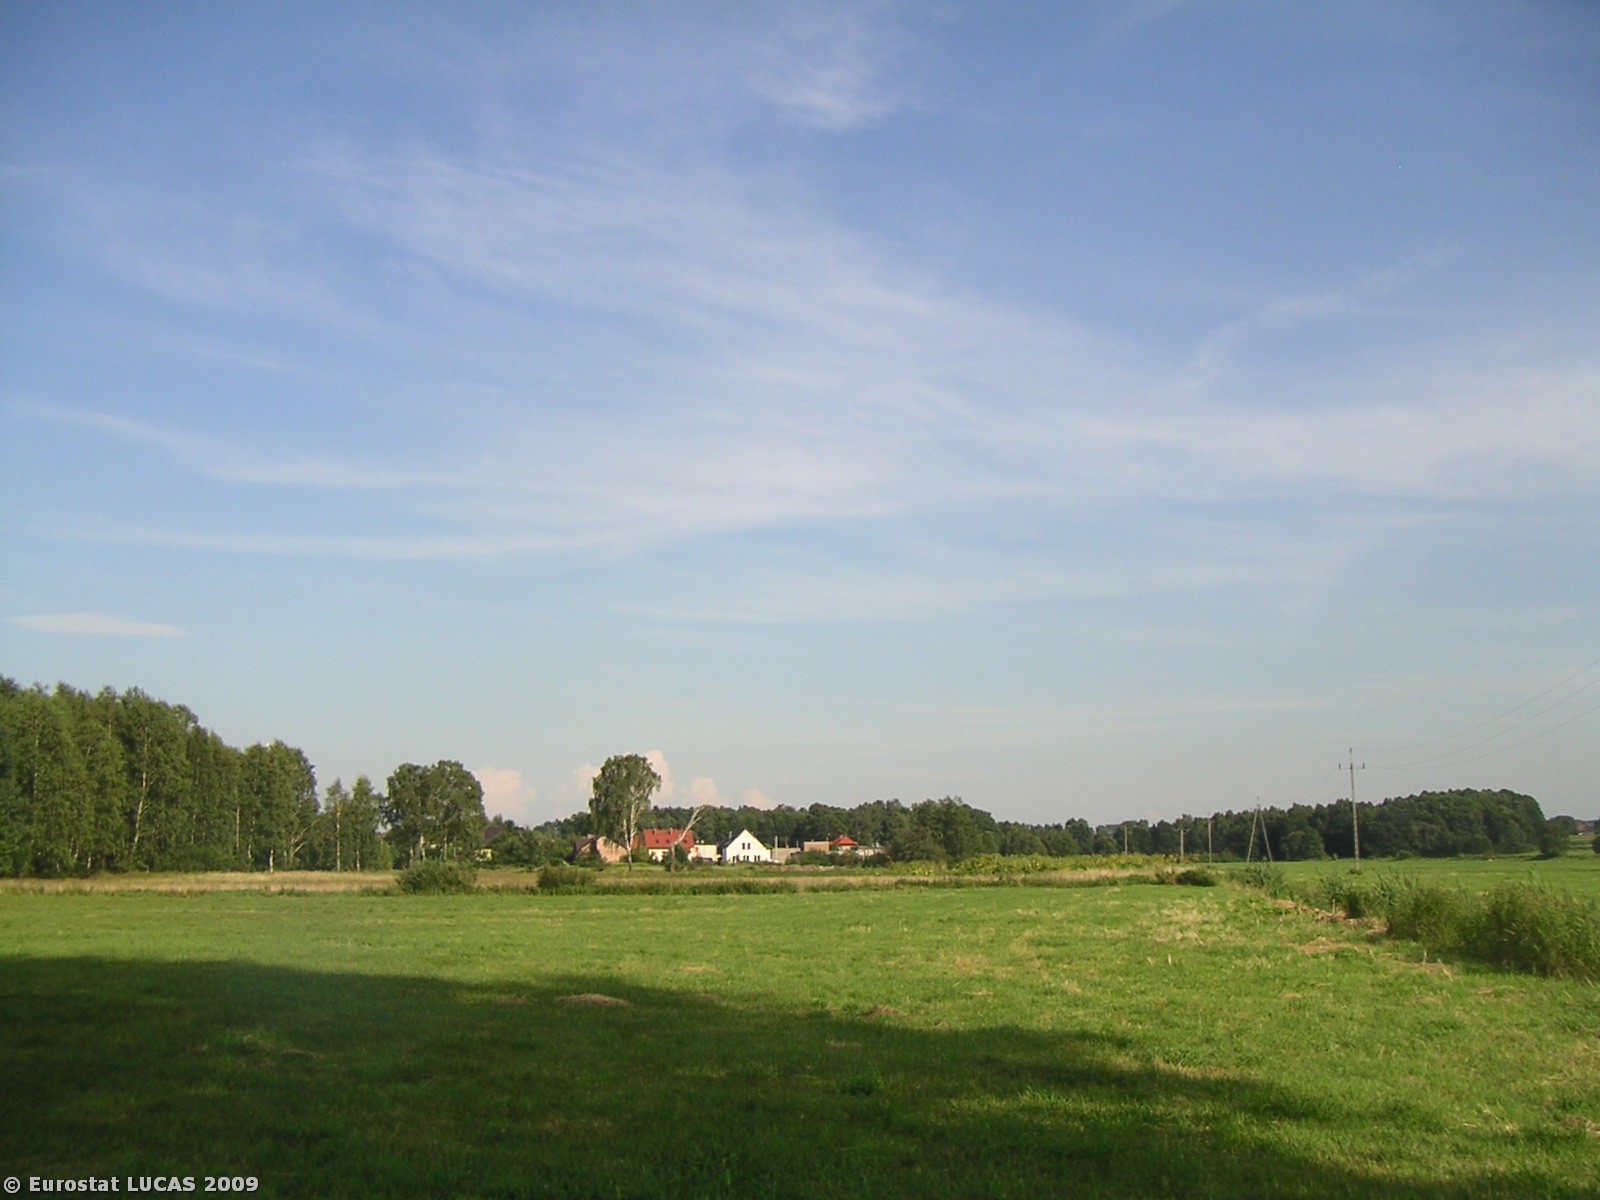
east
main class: Grassland
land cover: Grassland without tree/shrub cover
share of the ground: > 75 %
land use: Agriculture (excluding fallow land and kitchen gardens)
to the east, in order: Grassland without tree/shrub cover; Ditches and canals; Grassland without tree/shrub cover; Broadleaved woodland; Artificial constructions in urban areas
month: July
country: PL
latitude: 50.2226
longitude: 18.8096
